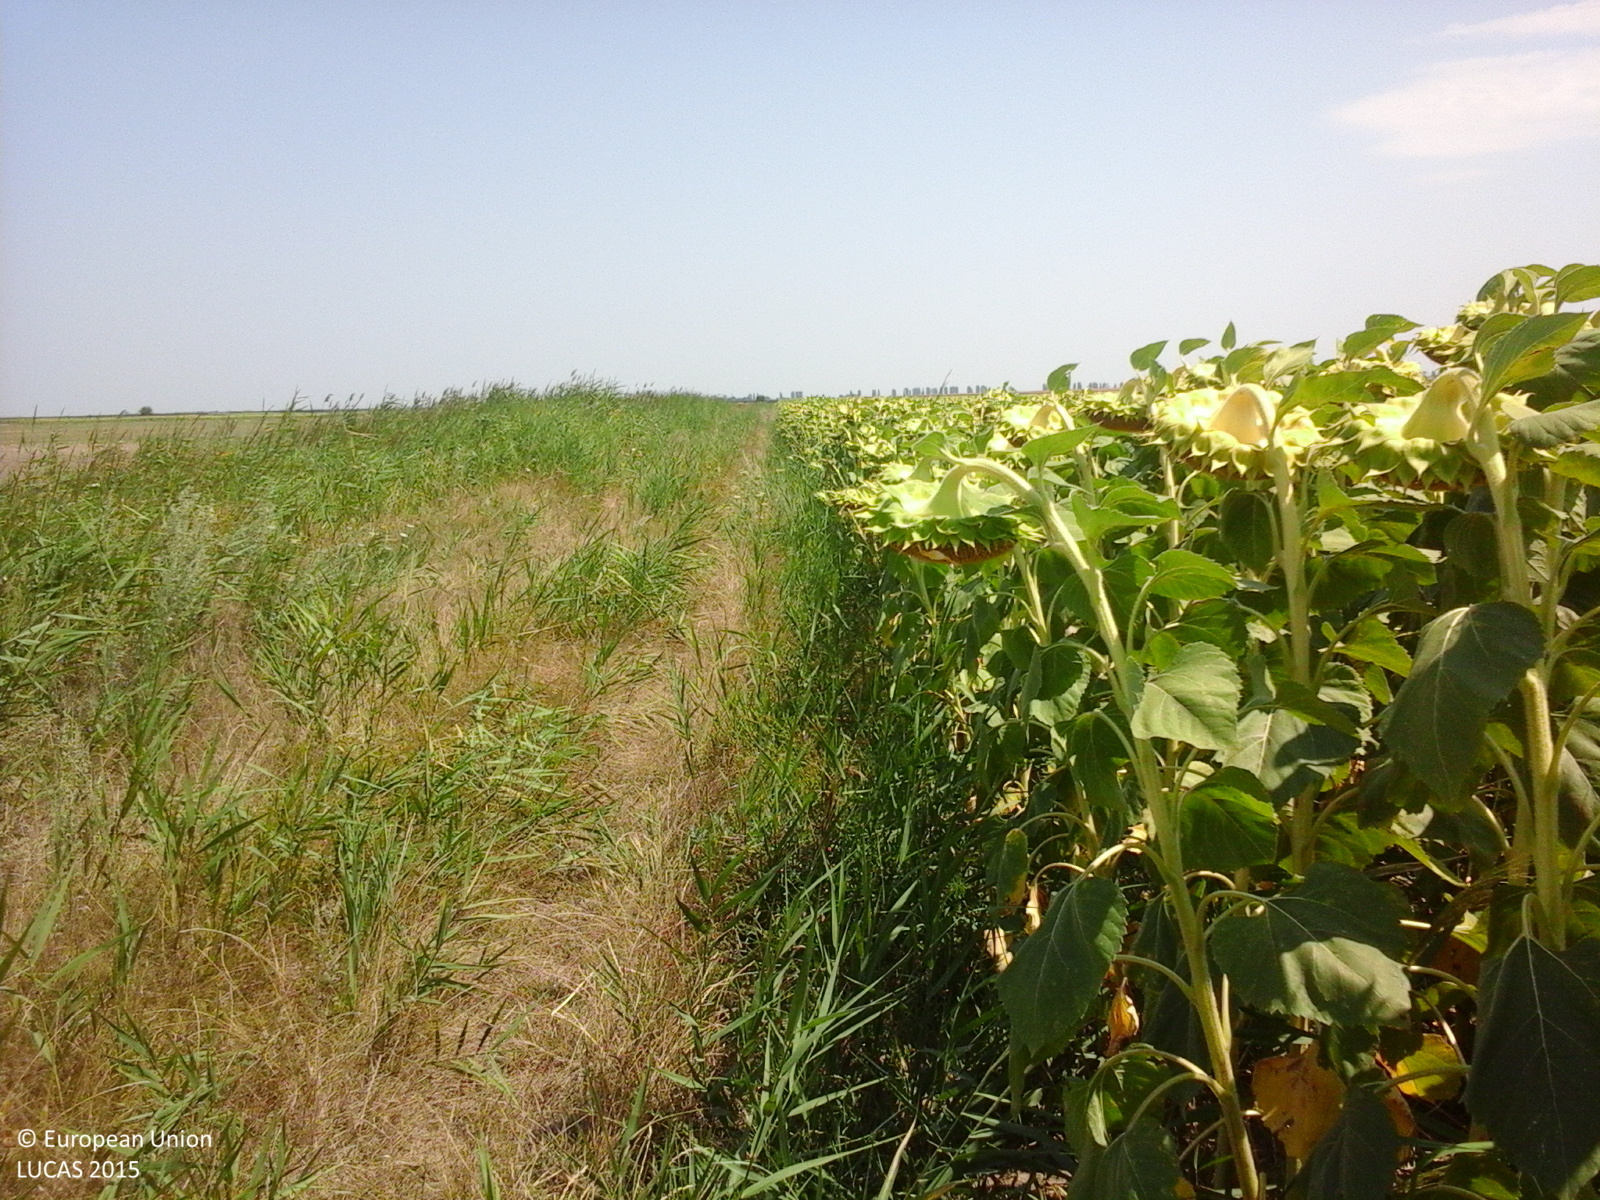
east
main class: Cropland
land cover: Sunflower
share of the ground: > 75 %
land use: Agriculture (excluding fallow land and kitchen gardens)
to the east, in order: Sunflower
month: August
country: RO
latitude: 45.3121
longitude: 27.7487
